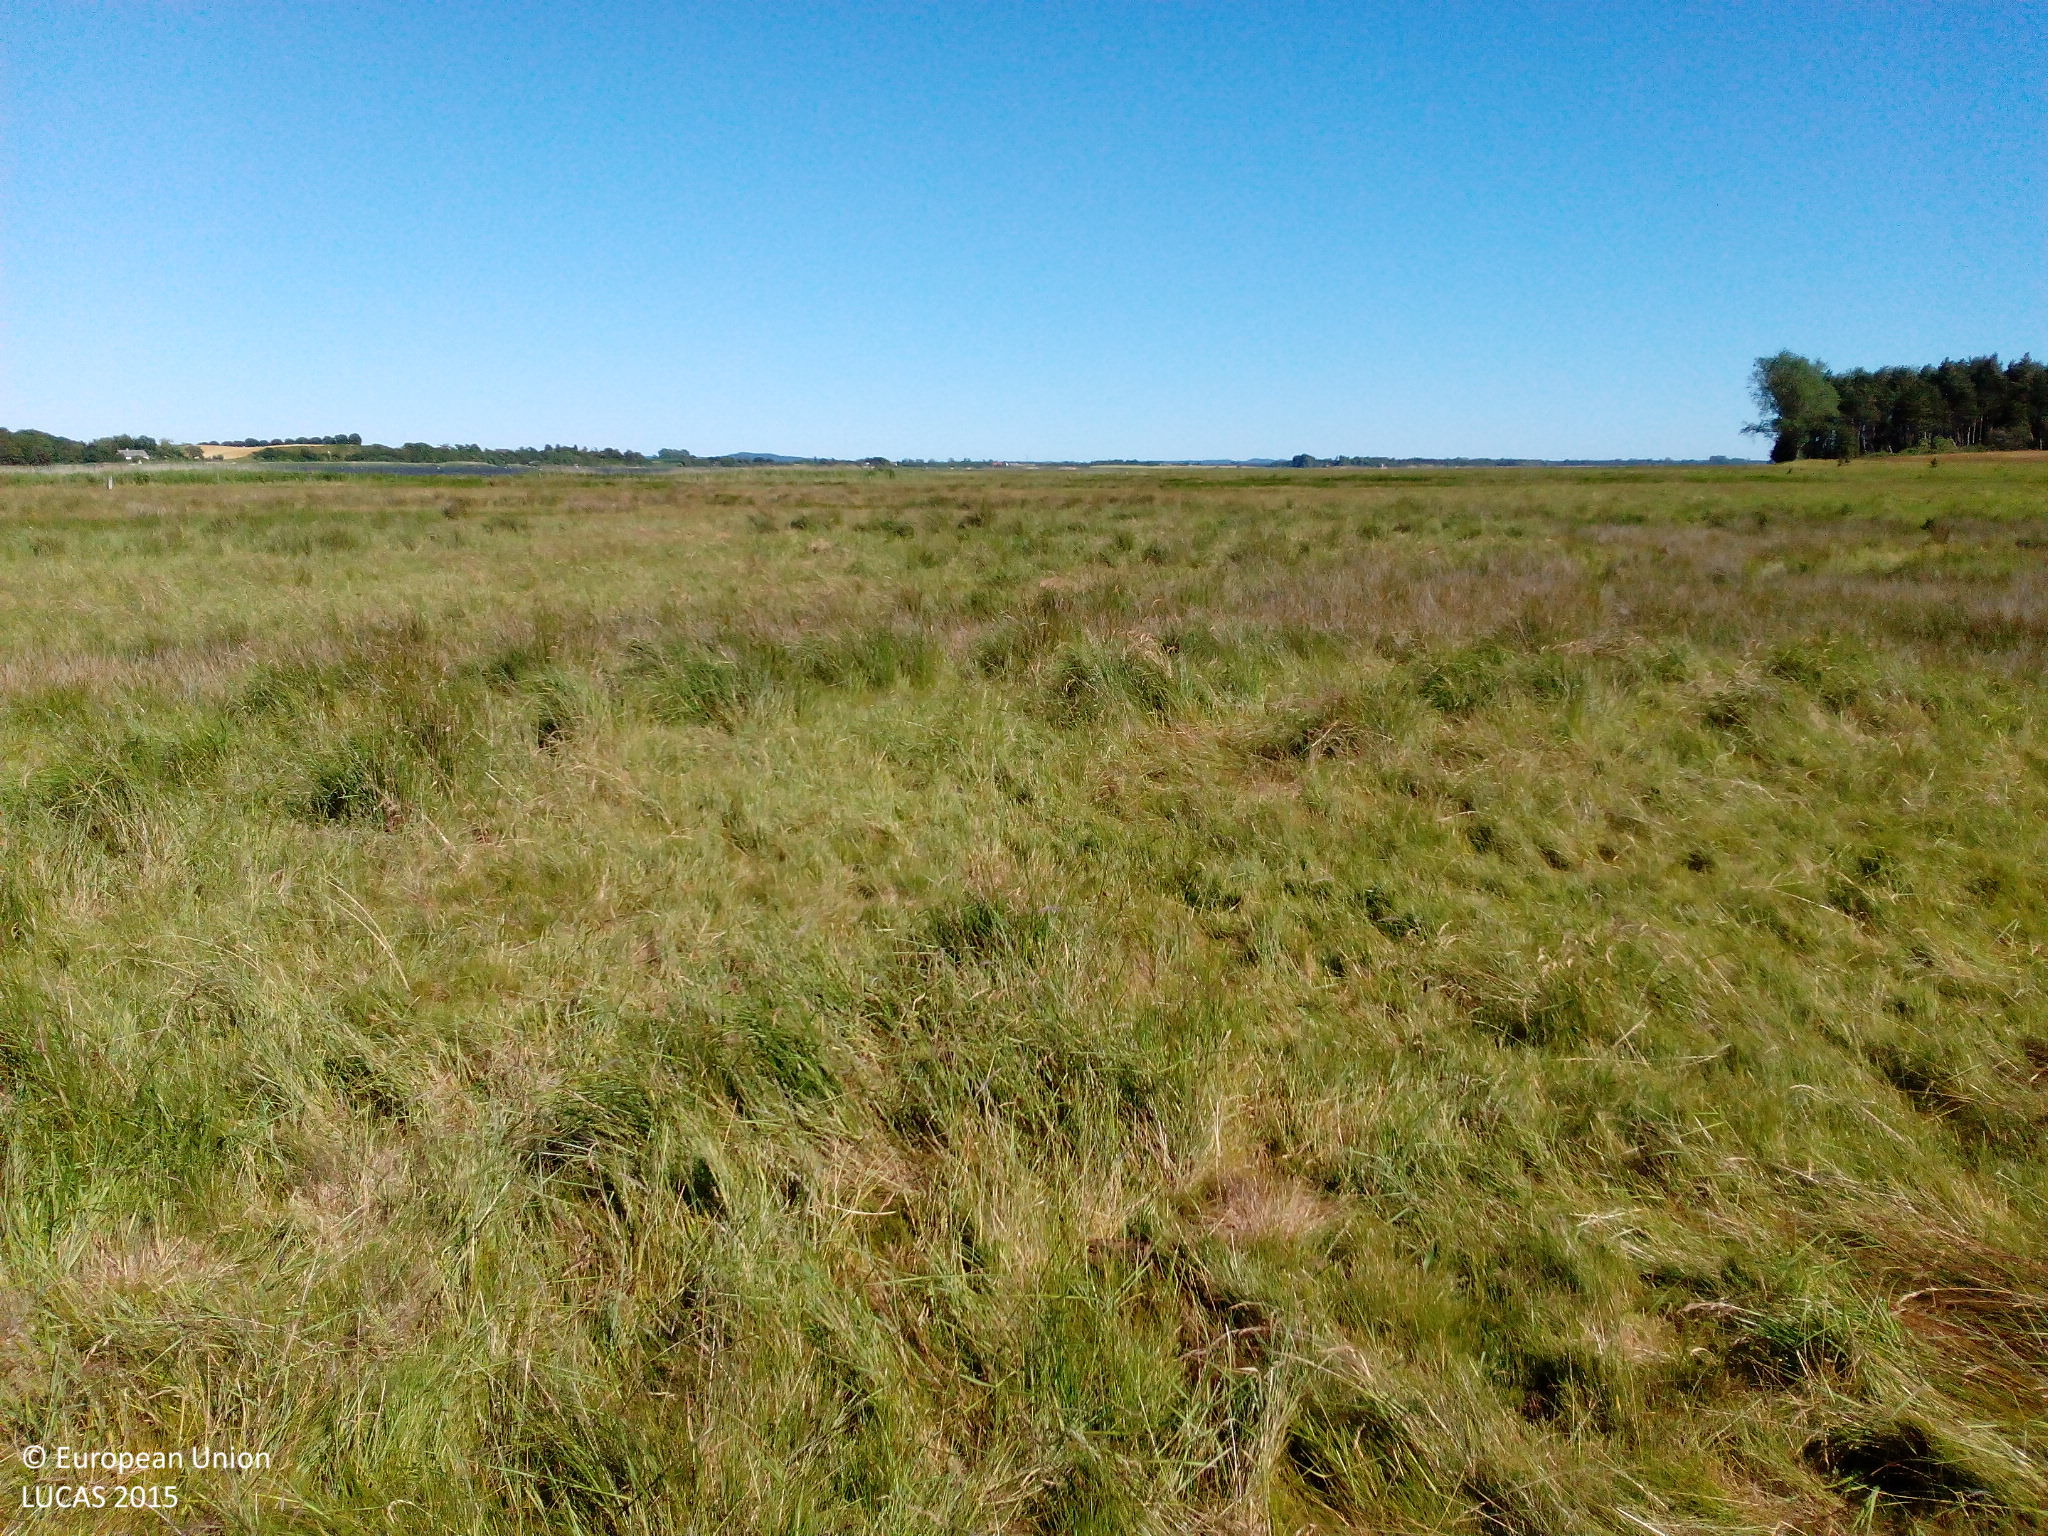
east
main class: Grassland
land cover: Grassland without tree/shrub cover
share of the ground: > 75 %
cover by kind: herbaceous plants 100 %
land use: Agriculture (excluding fallow land and kitchen gardens)
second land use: Amenities, museums, leisure
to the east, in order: Grassland without tree/shrub cover; Salt marshes; Grassland without tree/shrub cover; Salt marshes; Fences; Salt marshes; Intertidal flats
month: July
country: DK
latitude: 55.0789
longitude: 11.7687
